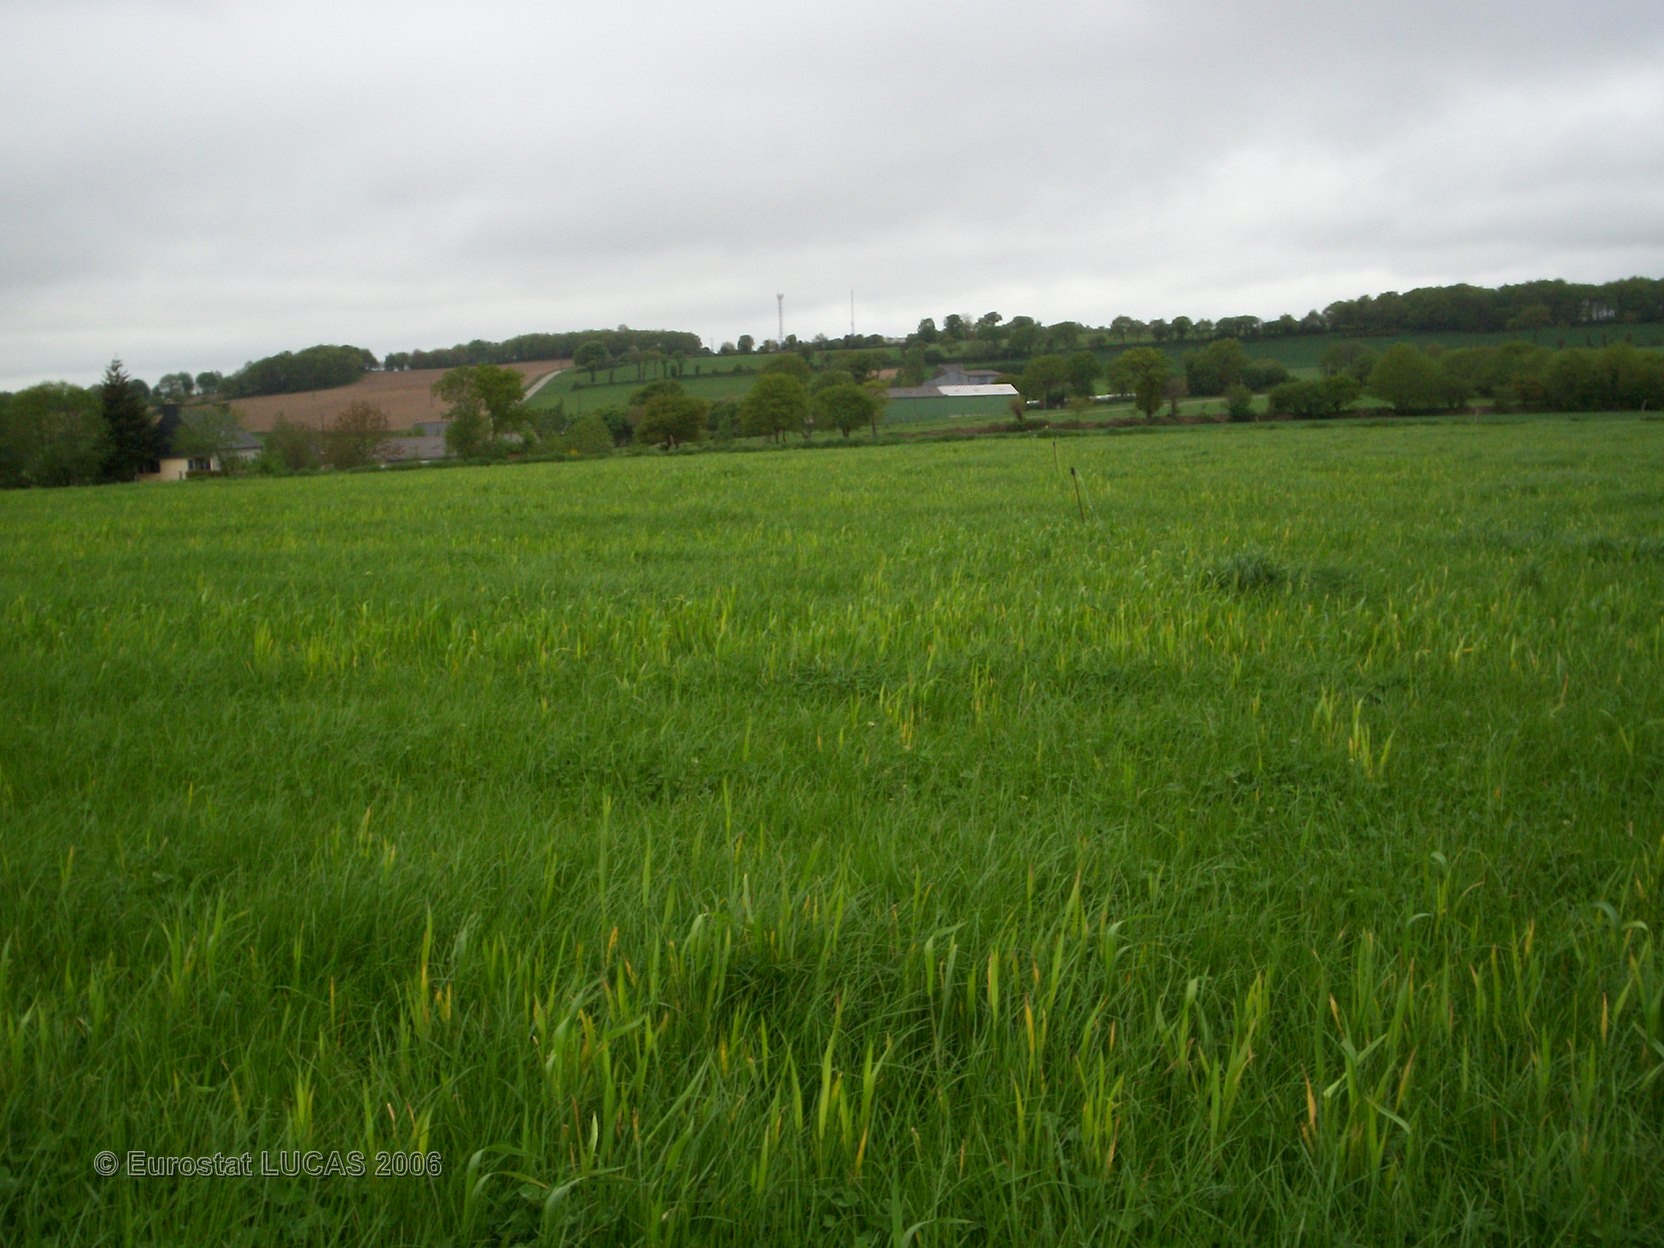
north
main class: Grassland
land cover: Grassland without tree/shrub cover
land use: Agriculture (excluding fallow land and kitchen gardens)
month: May
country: FR
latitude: 48.2899
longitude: -2.8300
